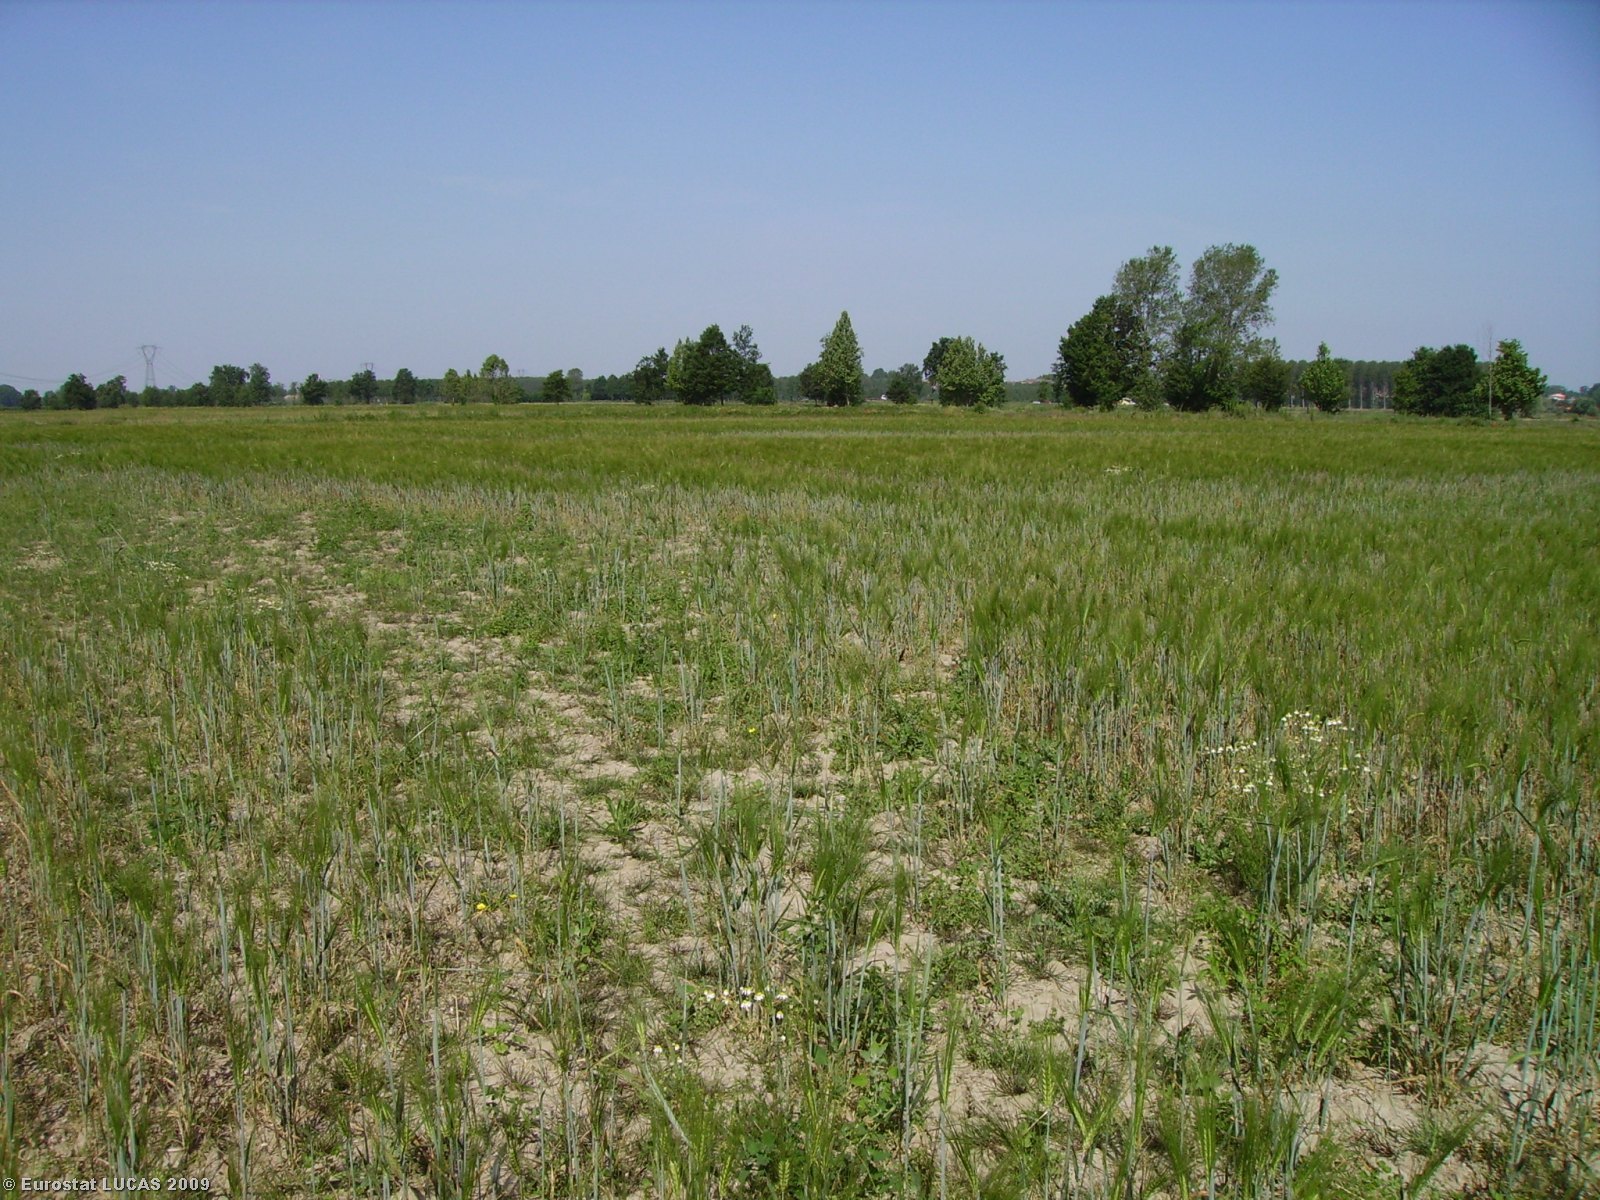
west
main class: Cropland
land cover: Common wheat
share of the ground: 50 - 75 %
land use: Agriculture (excluding fallow land and kitchen gardens)
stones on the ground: < 10 %
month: May
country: IT
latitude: 45.1427
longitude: 9.5050
